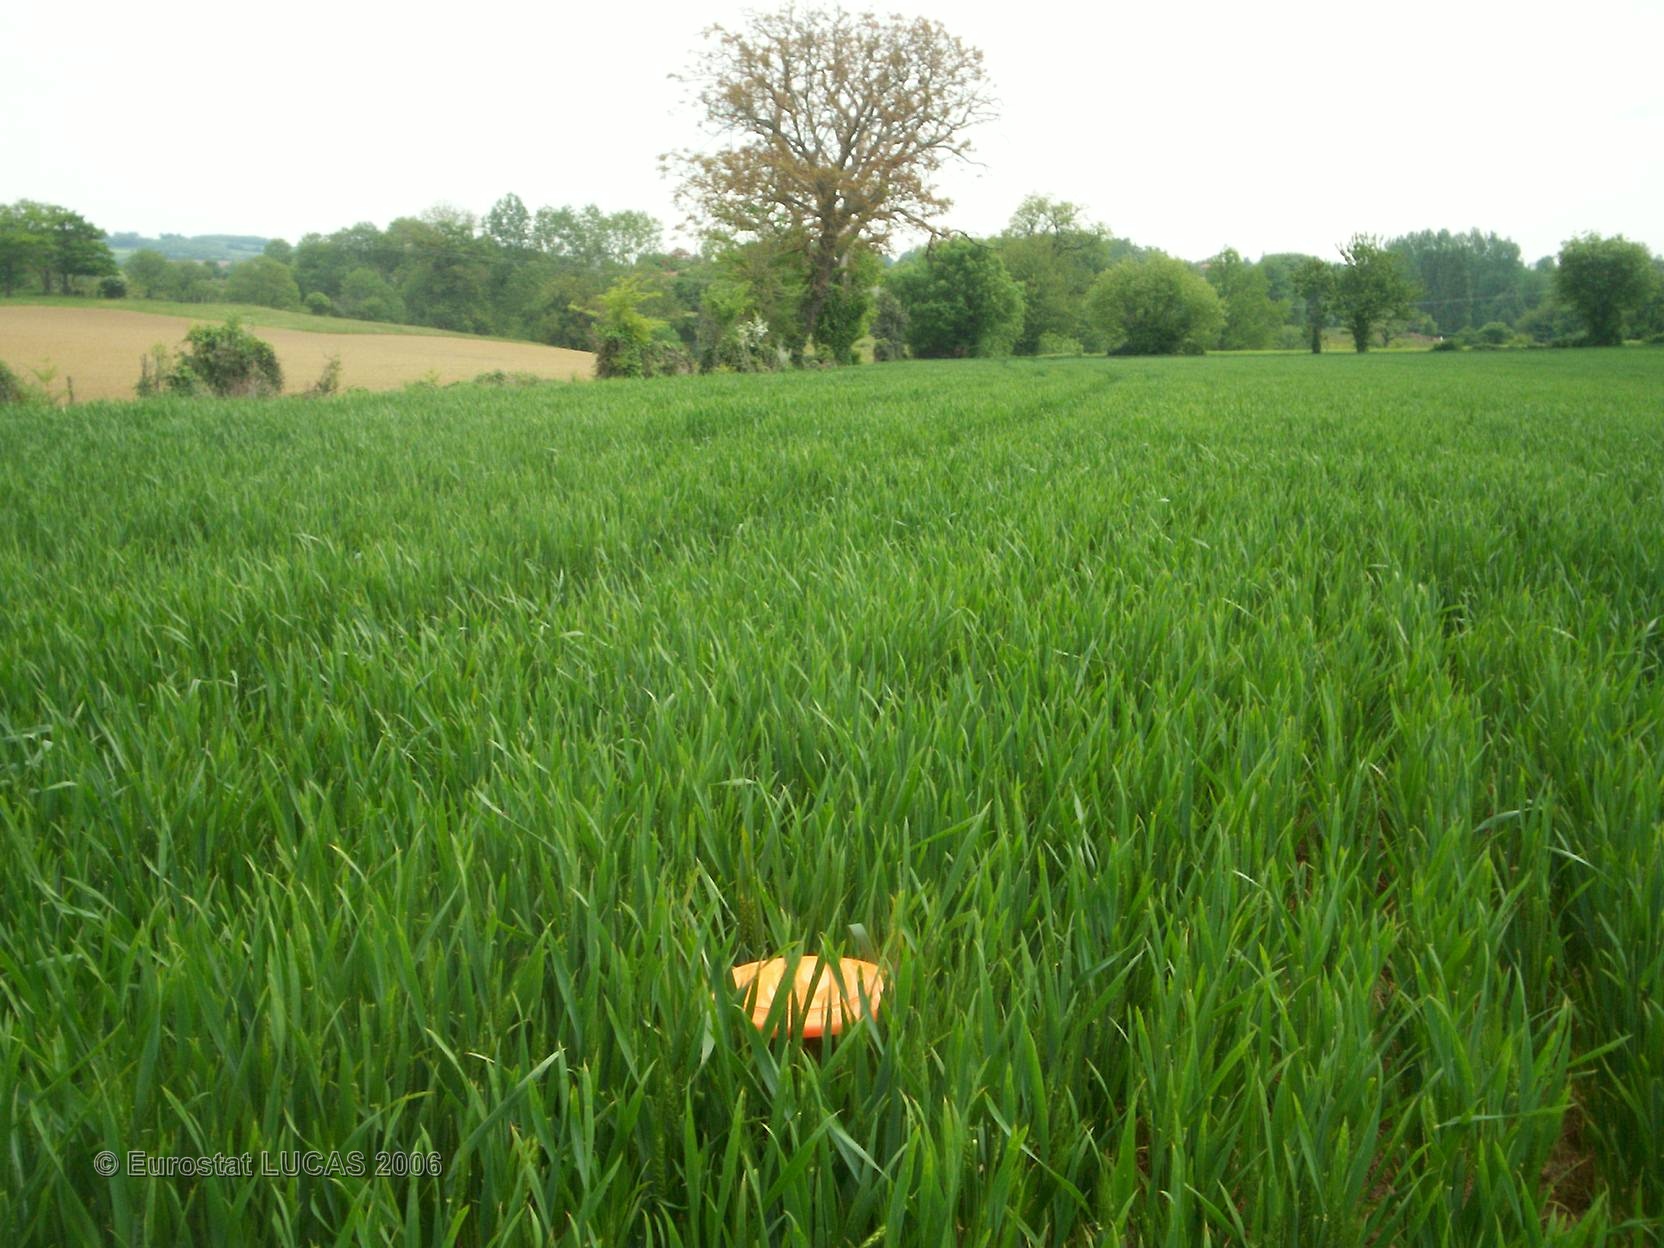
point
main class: Cropland
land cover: Barley
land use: Agriculture (excluding fallow land and kitchen gardens)
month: May
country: FR
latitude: 46.7620
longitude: -0.8332
